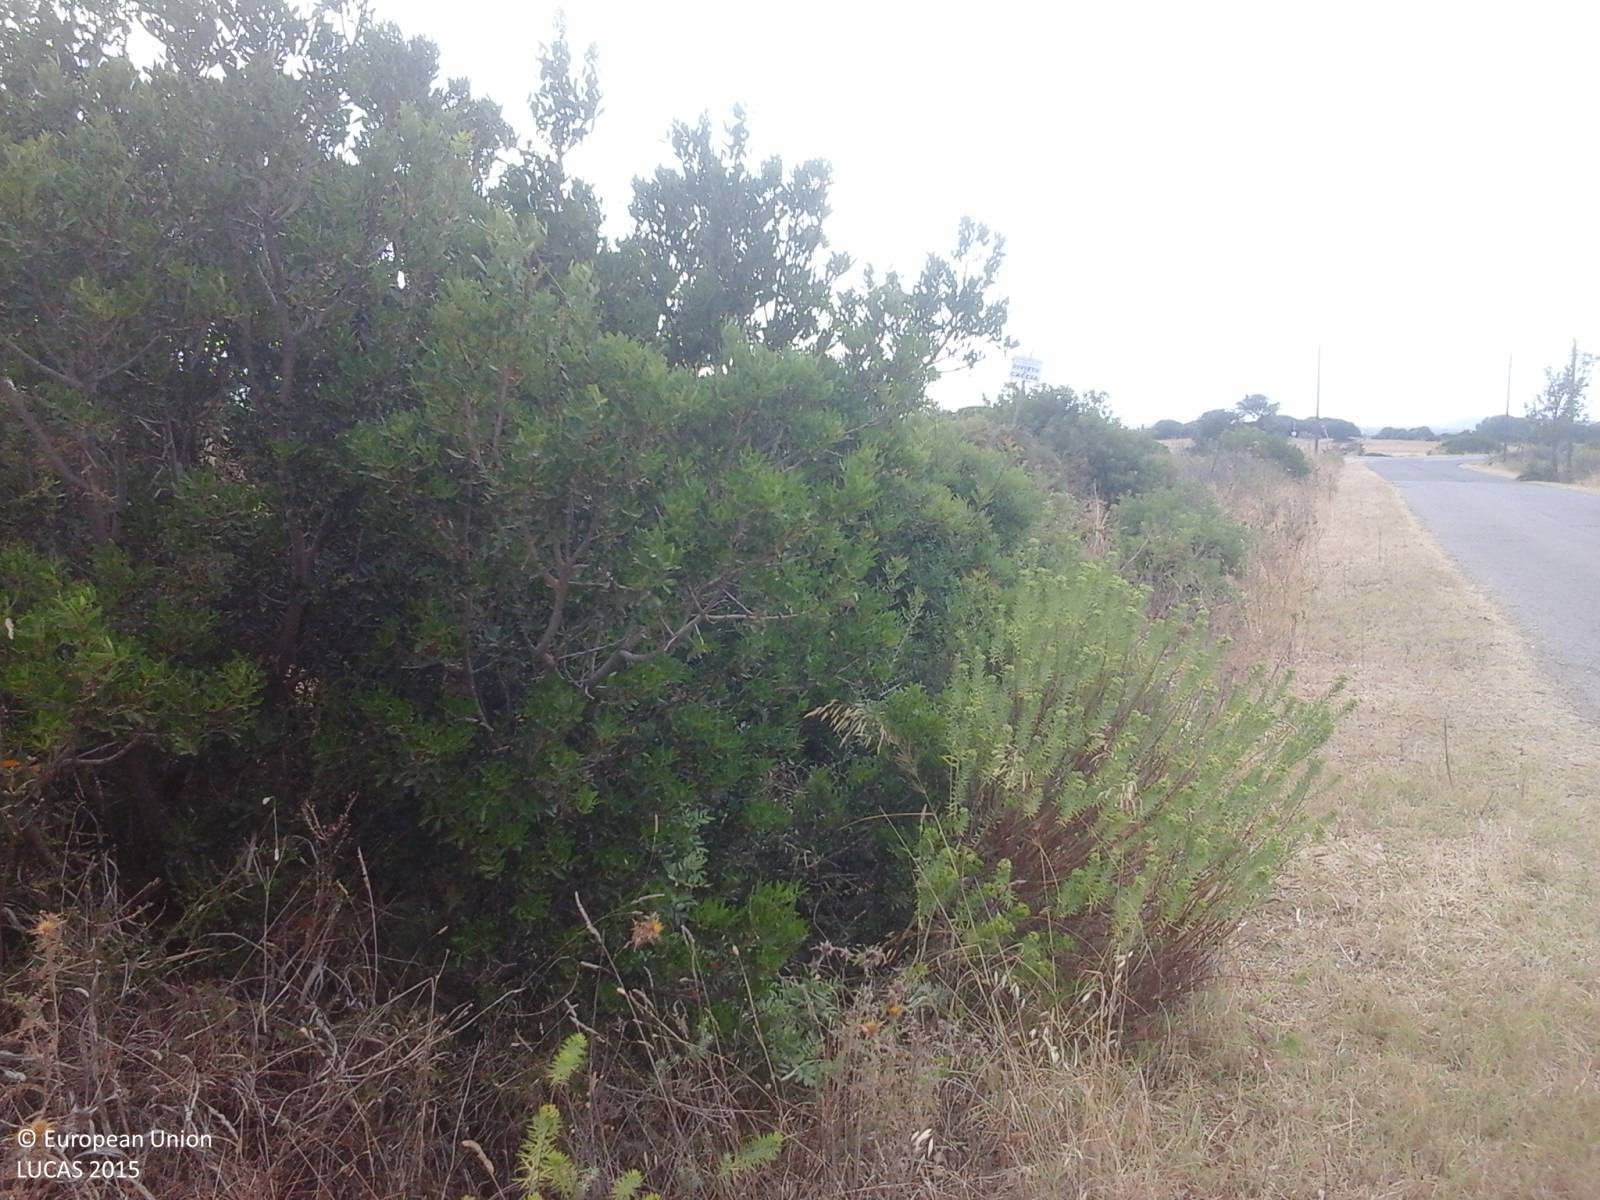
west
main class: Shrubland
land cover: Shrubland without tree cover
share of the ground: > 75 %
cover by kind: shrubs 60 %, herbaceous plants 30 %, unconsolidated bare surface 10 %
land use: Agriculture (excluding fallow land and kitchen gardens)
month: July
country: IT
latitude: 39.1155
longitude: 8.5633
